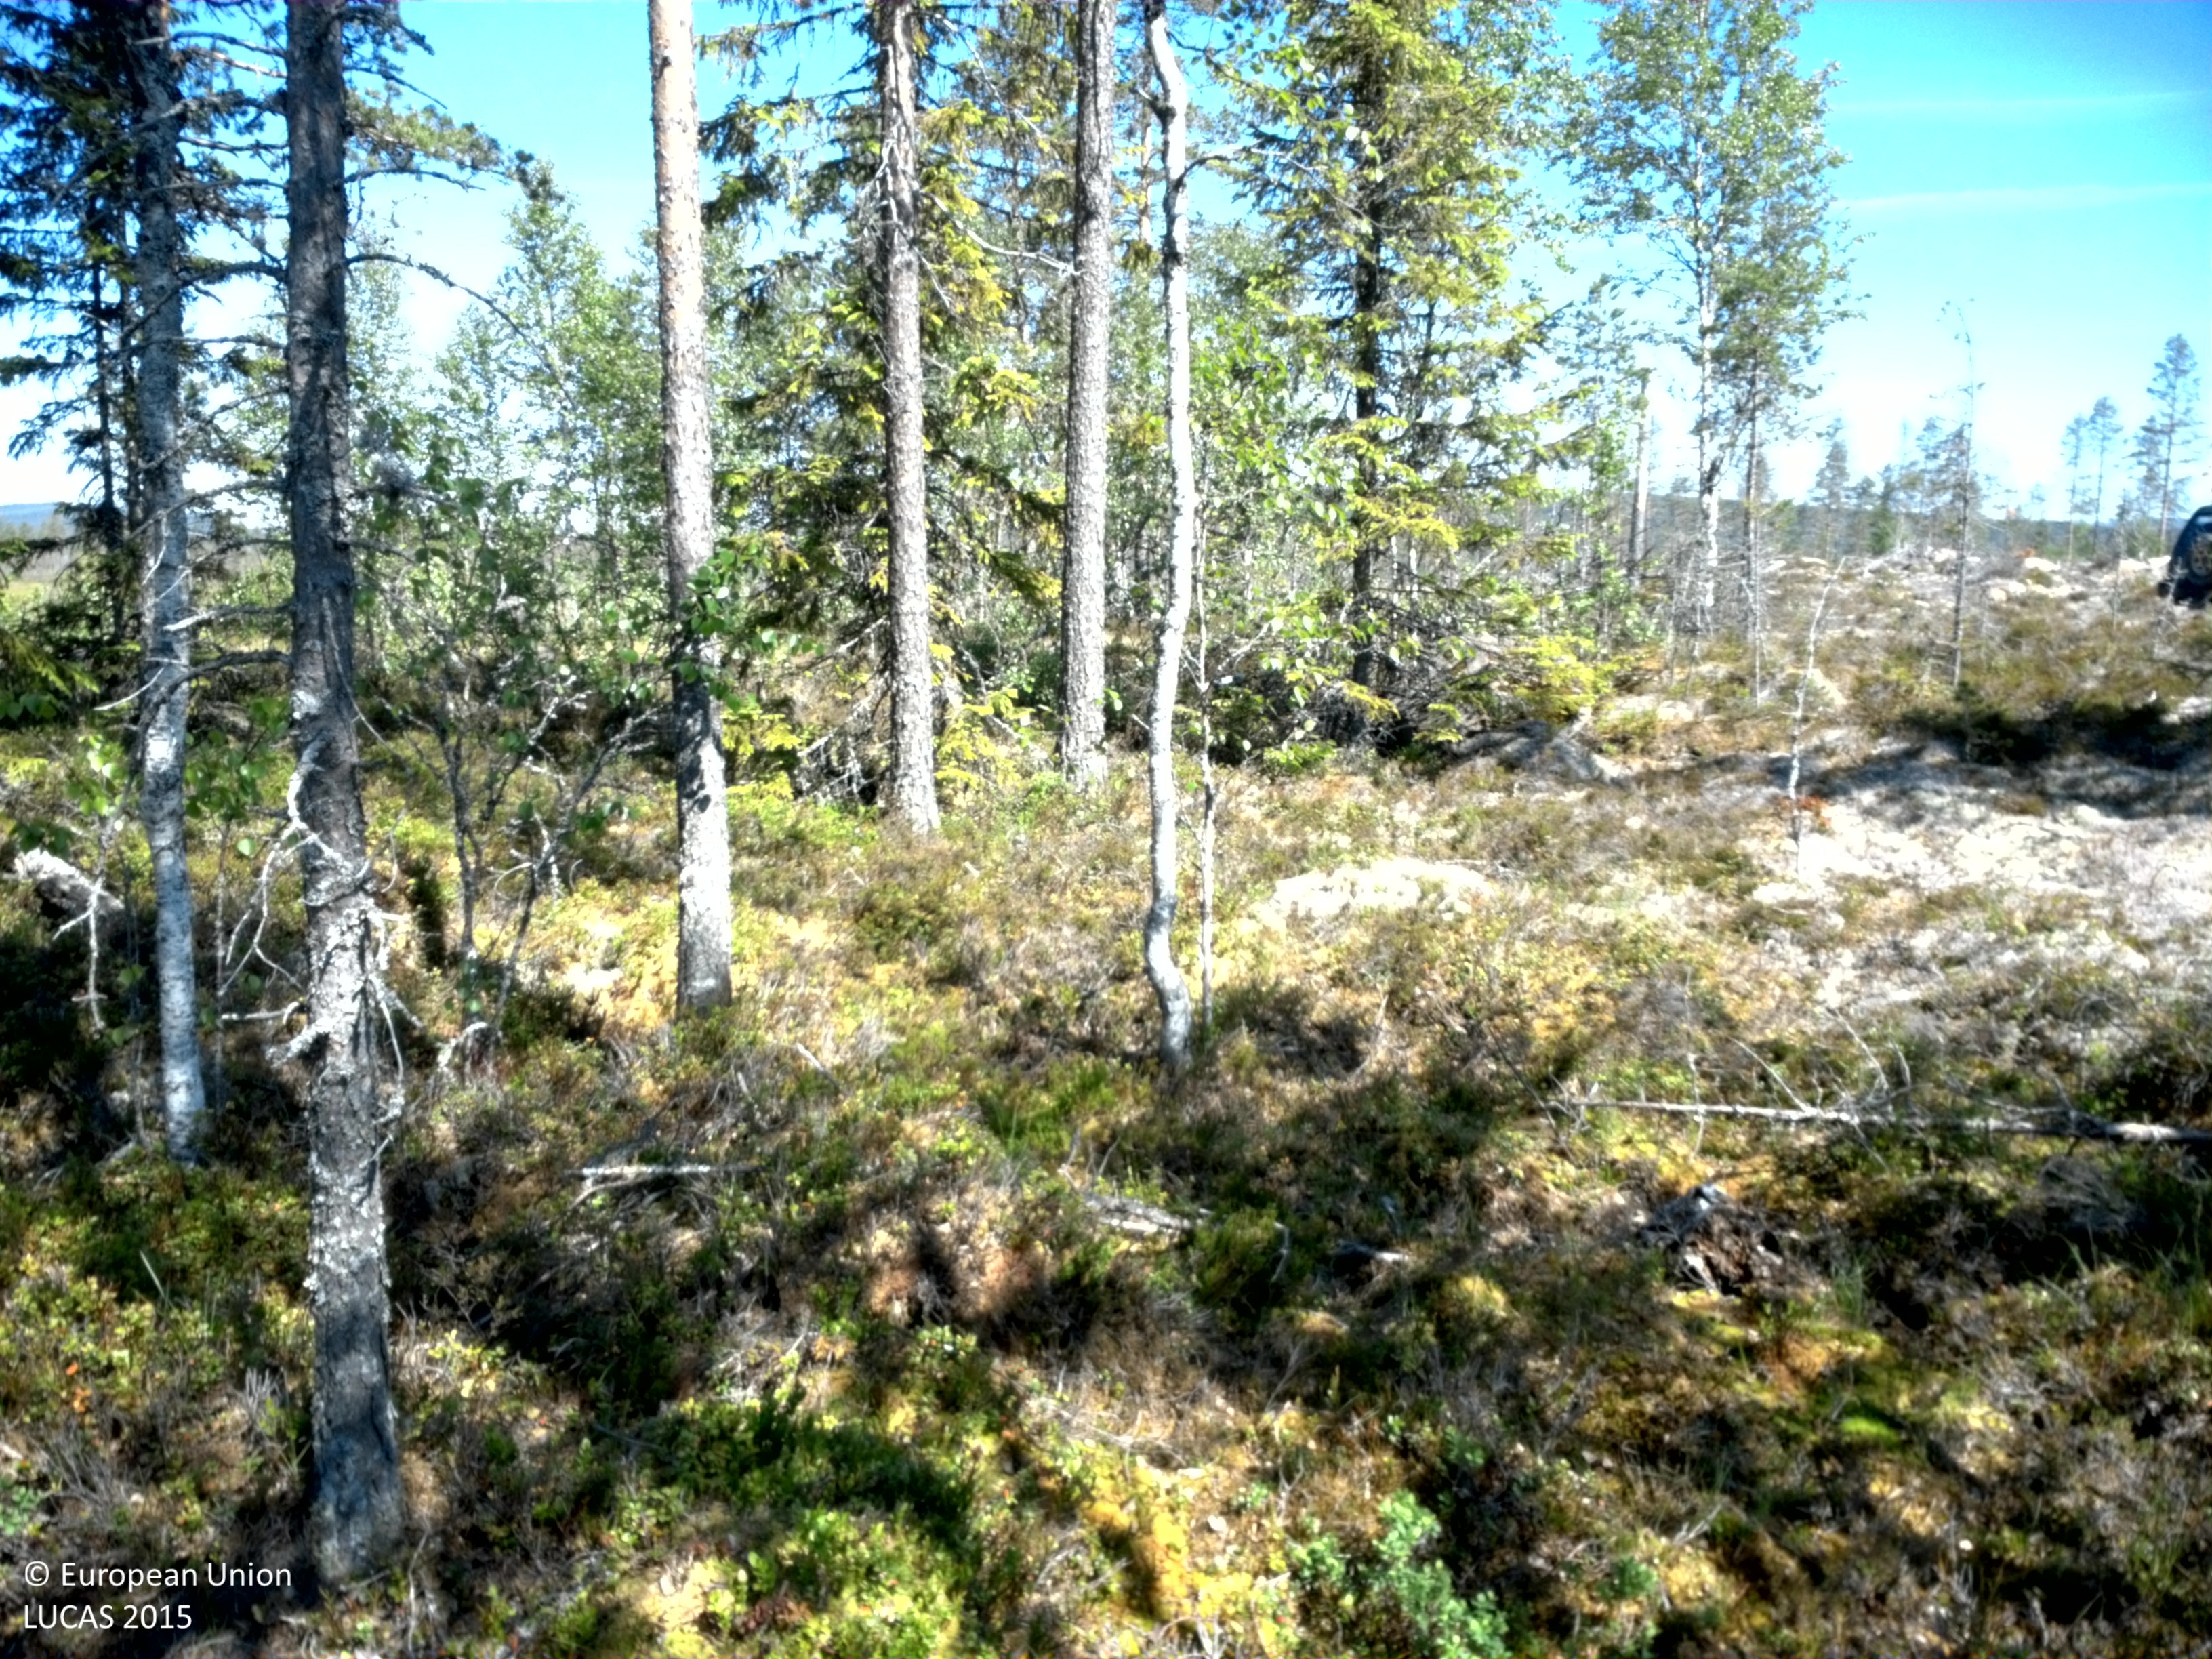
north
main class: Woodland
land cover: Pine dominated mixed woodland
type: boreal forest
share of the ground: 10 - 25 %
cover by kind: shrubs 40 %, lichens and mosses 30 %, herbaceous plants 20 %, coniferous forest trees 5 %, broadleaved forest trees 5 %
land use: Forestry
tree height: > 5 m
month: June
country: SE
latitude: 60.7528
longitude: 12.5054
